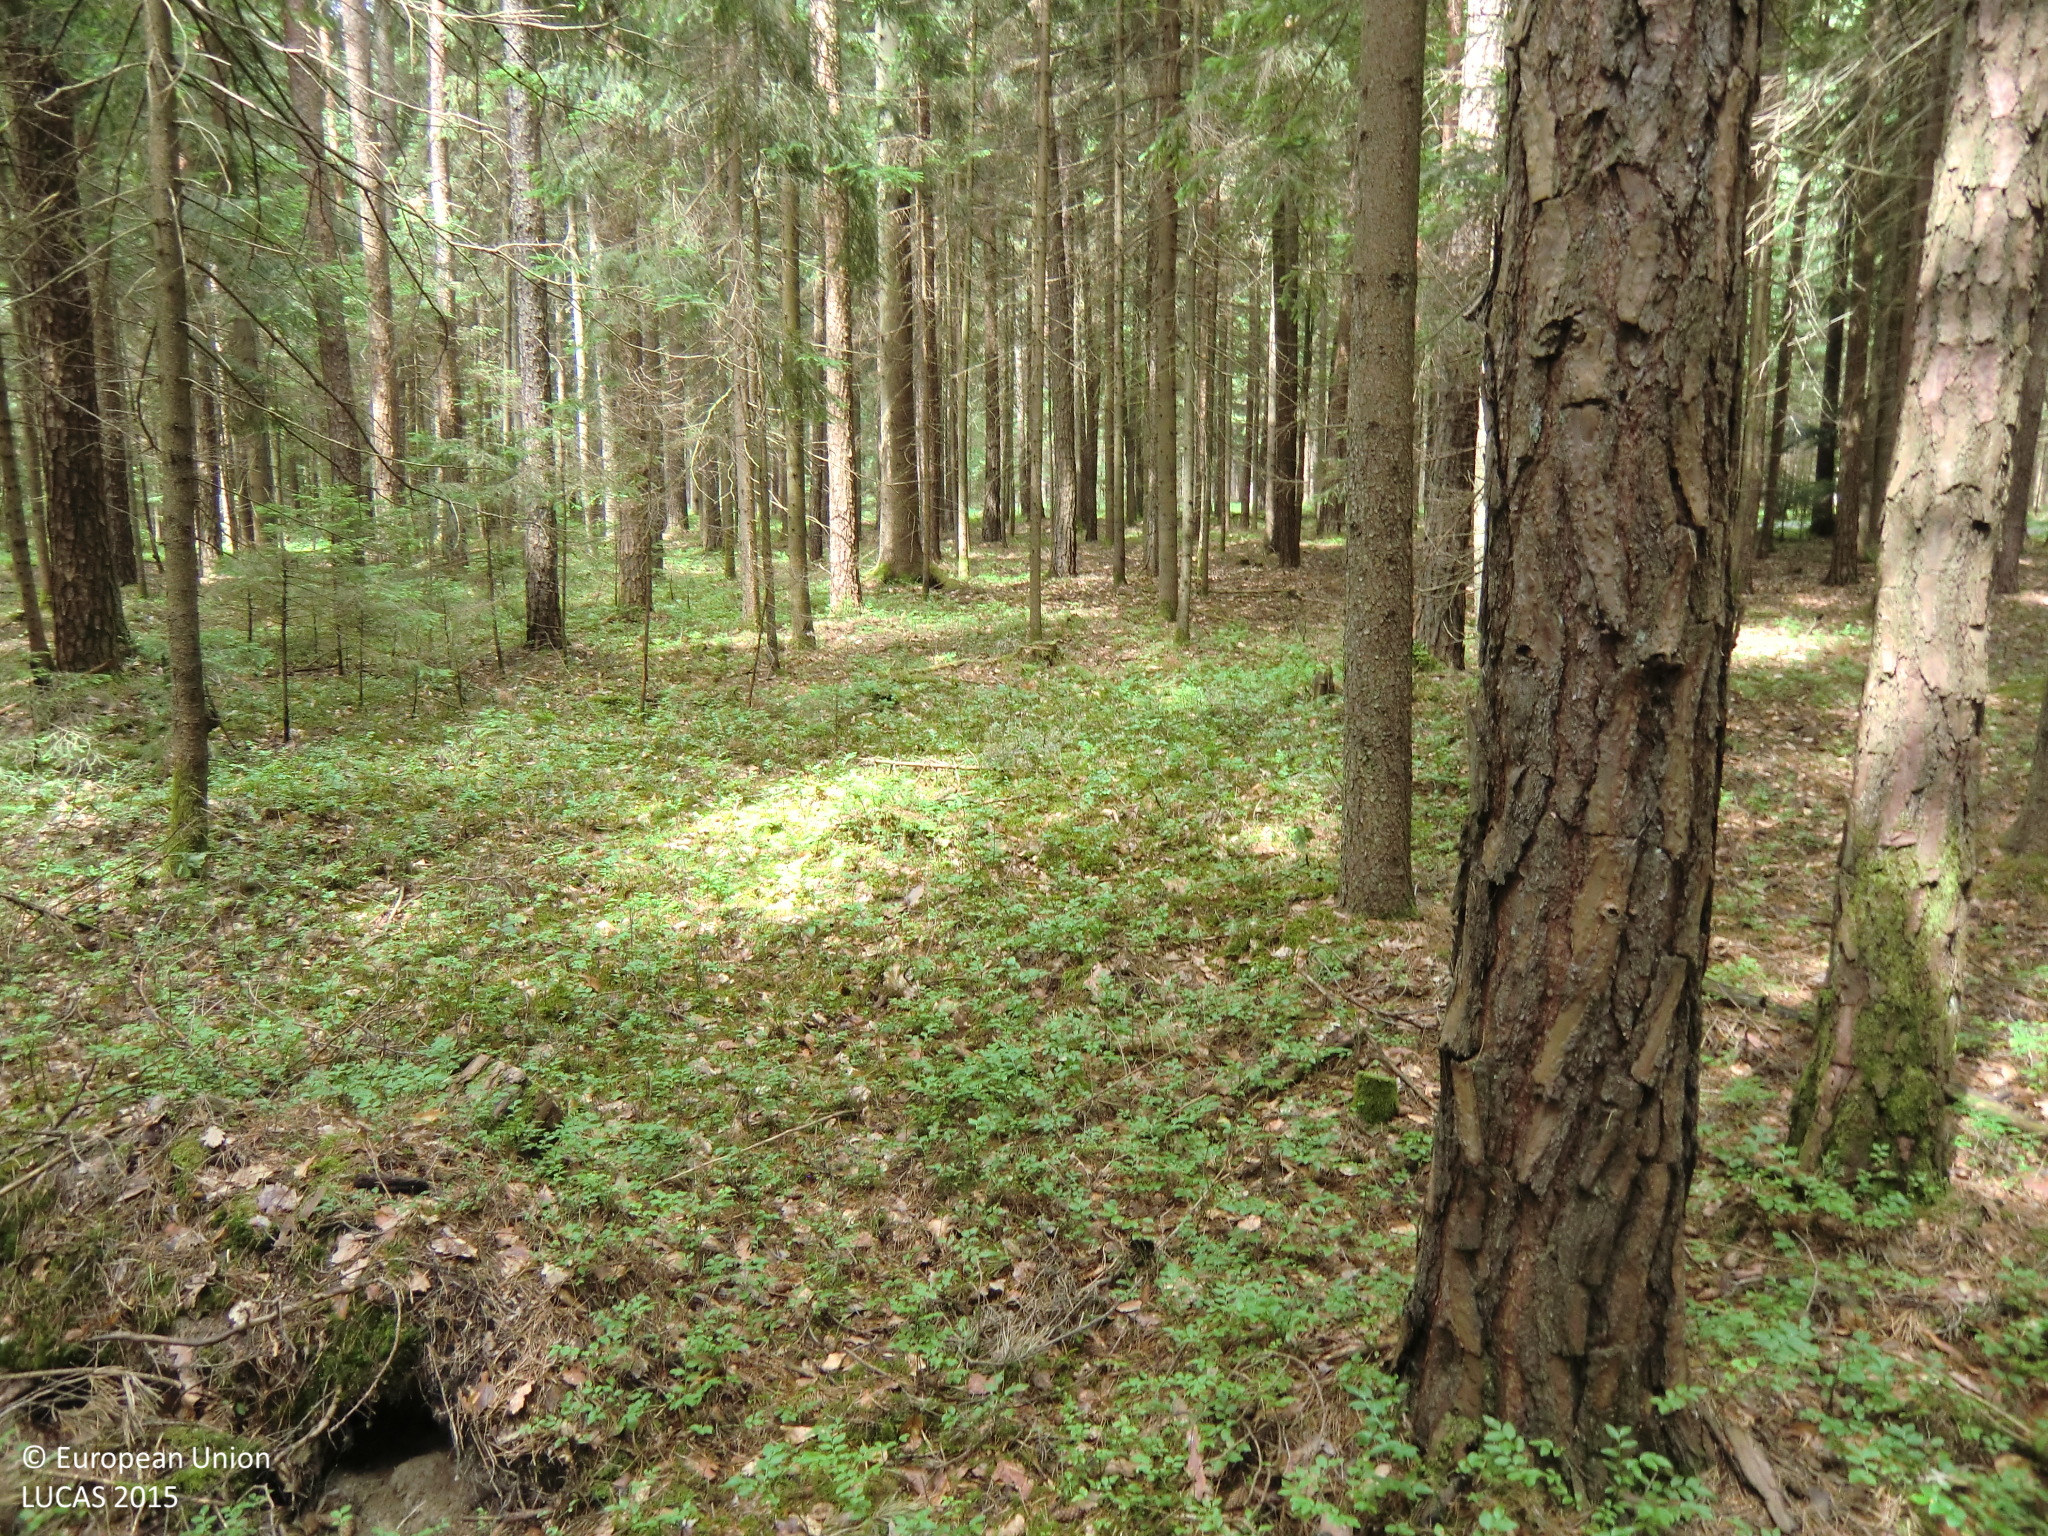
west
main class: Woodland
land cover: Pine dominated coniferous woodland
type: hemiboreal forest and nemoral coniferous forest and mixed broadleaved-coniferous forest
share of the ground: 50 - 75 %
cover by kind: coniferous forest trees 60 %, shrubs 20 %, unconsolidated bare surface 20 %
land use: Forestry
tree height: > 5 m
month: June
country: AT
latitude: 47.2623
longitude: 16.0679
